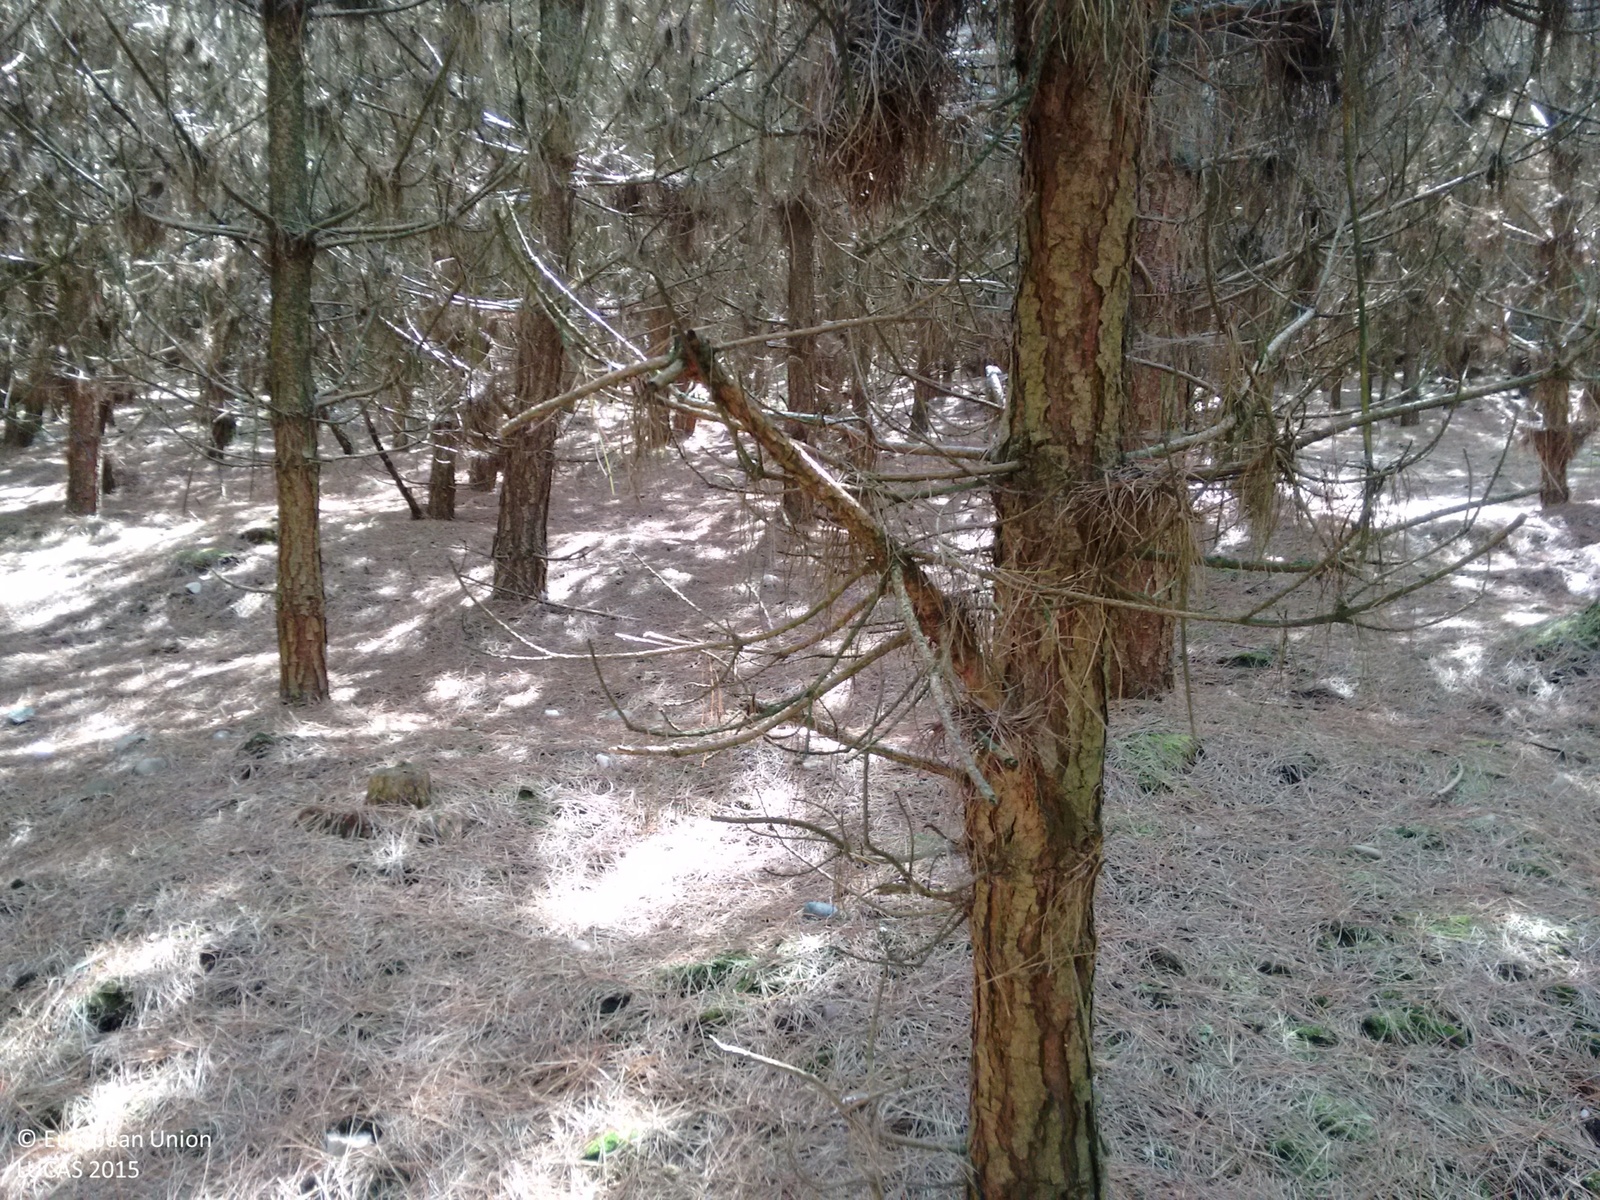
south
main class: Woodland
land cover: Pine dominated coniferous woodland
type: exotic forest
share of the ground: > 75 %
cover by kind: coniferous forest trees 100 %
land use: Forestry
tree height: > 5 m
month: August
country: GB
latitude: 52.7437
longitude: -2.0425
